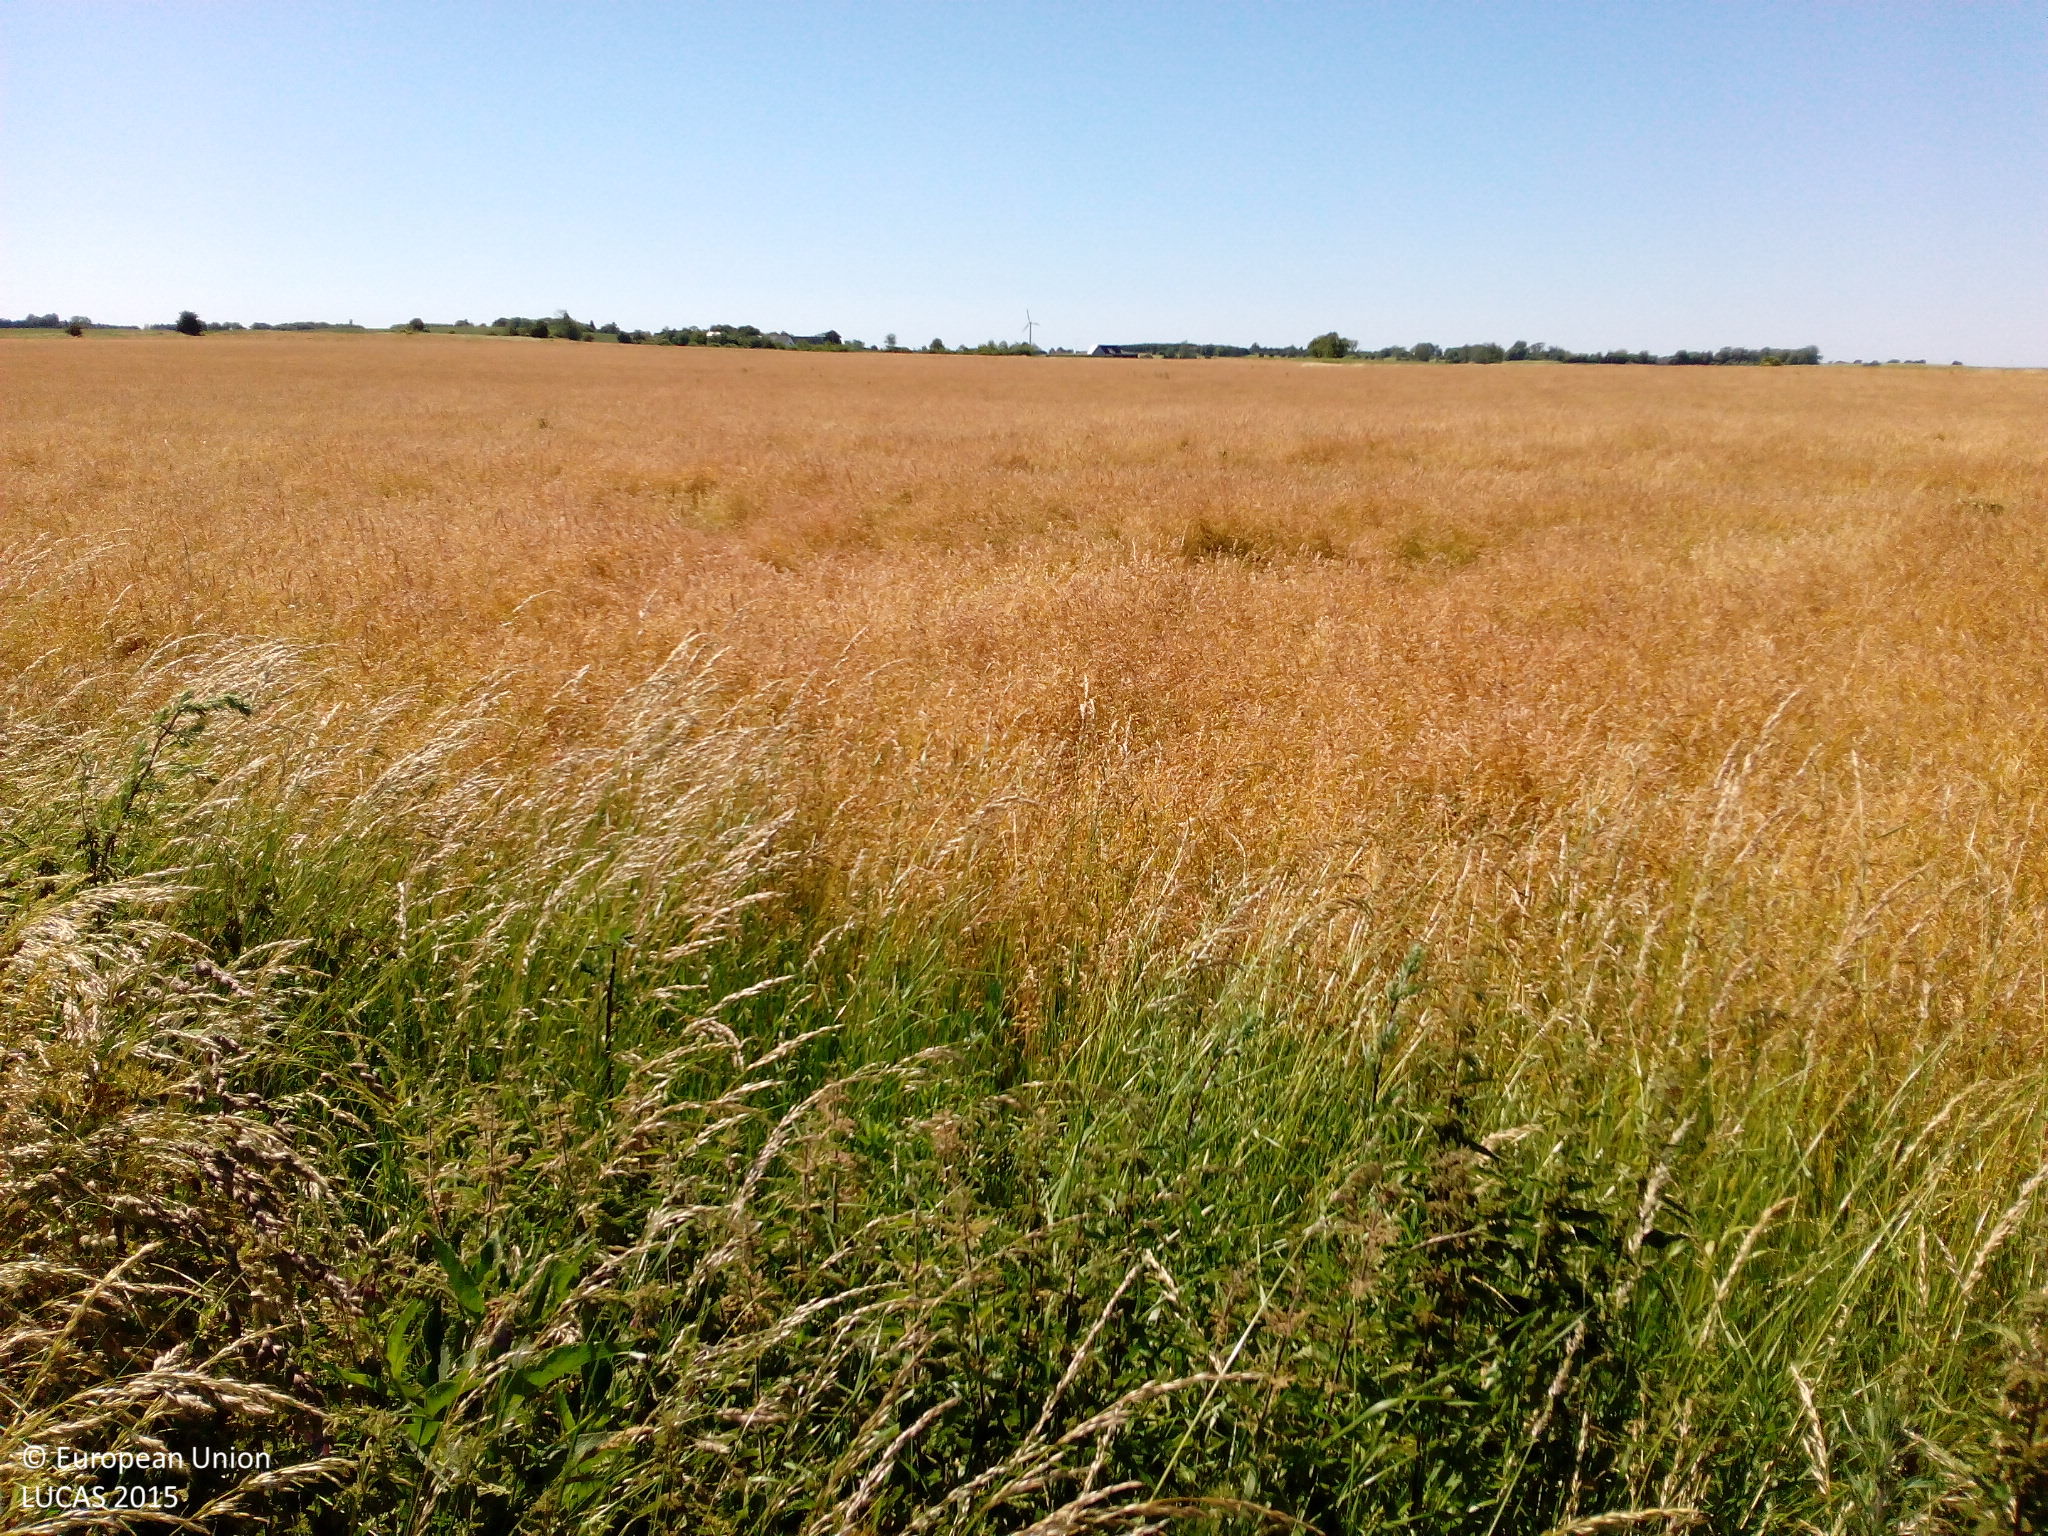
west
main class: Cropland
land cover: Rape and turnip rape
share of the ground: > 75 %
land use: Agriculture (excluding fallow land and kitchen gardens)
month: July
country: DK
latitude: 55.1148
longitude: 11.7703
